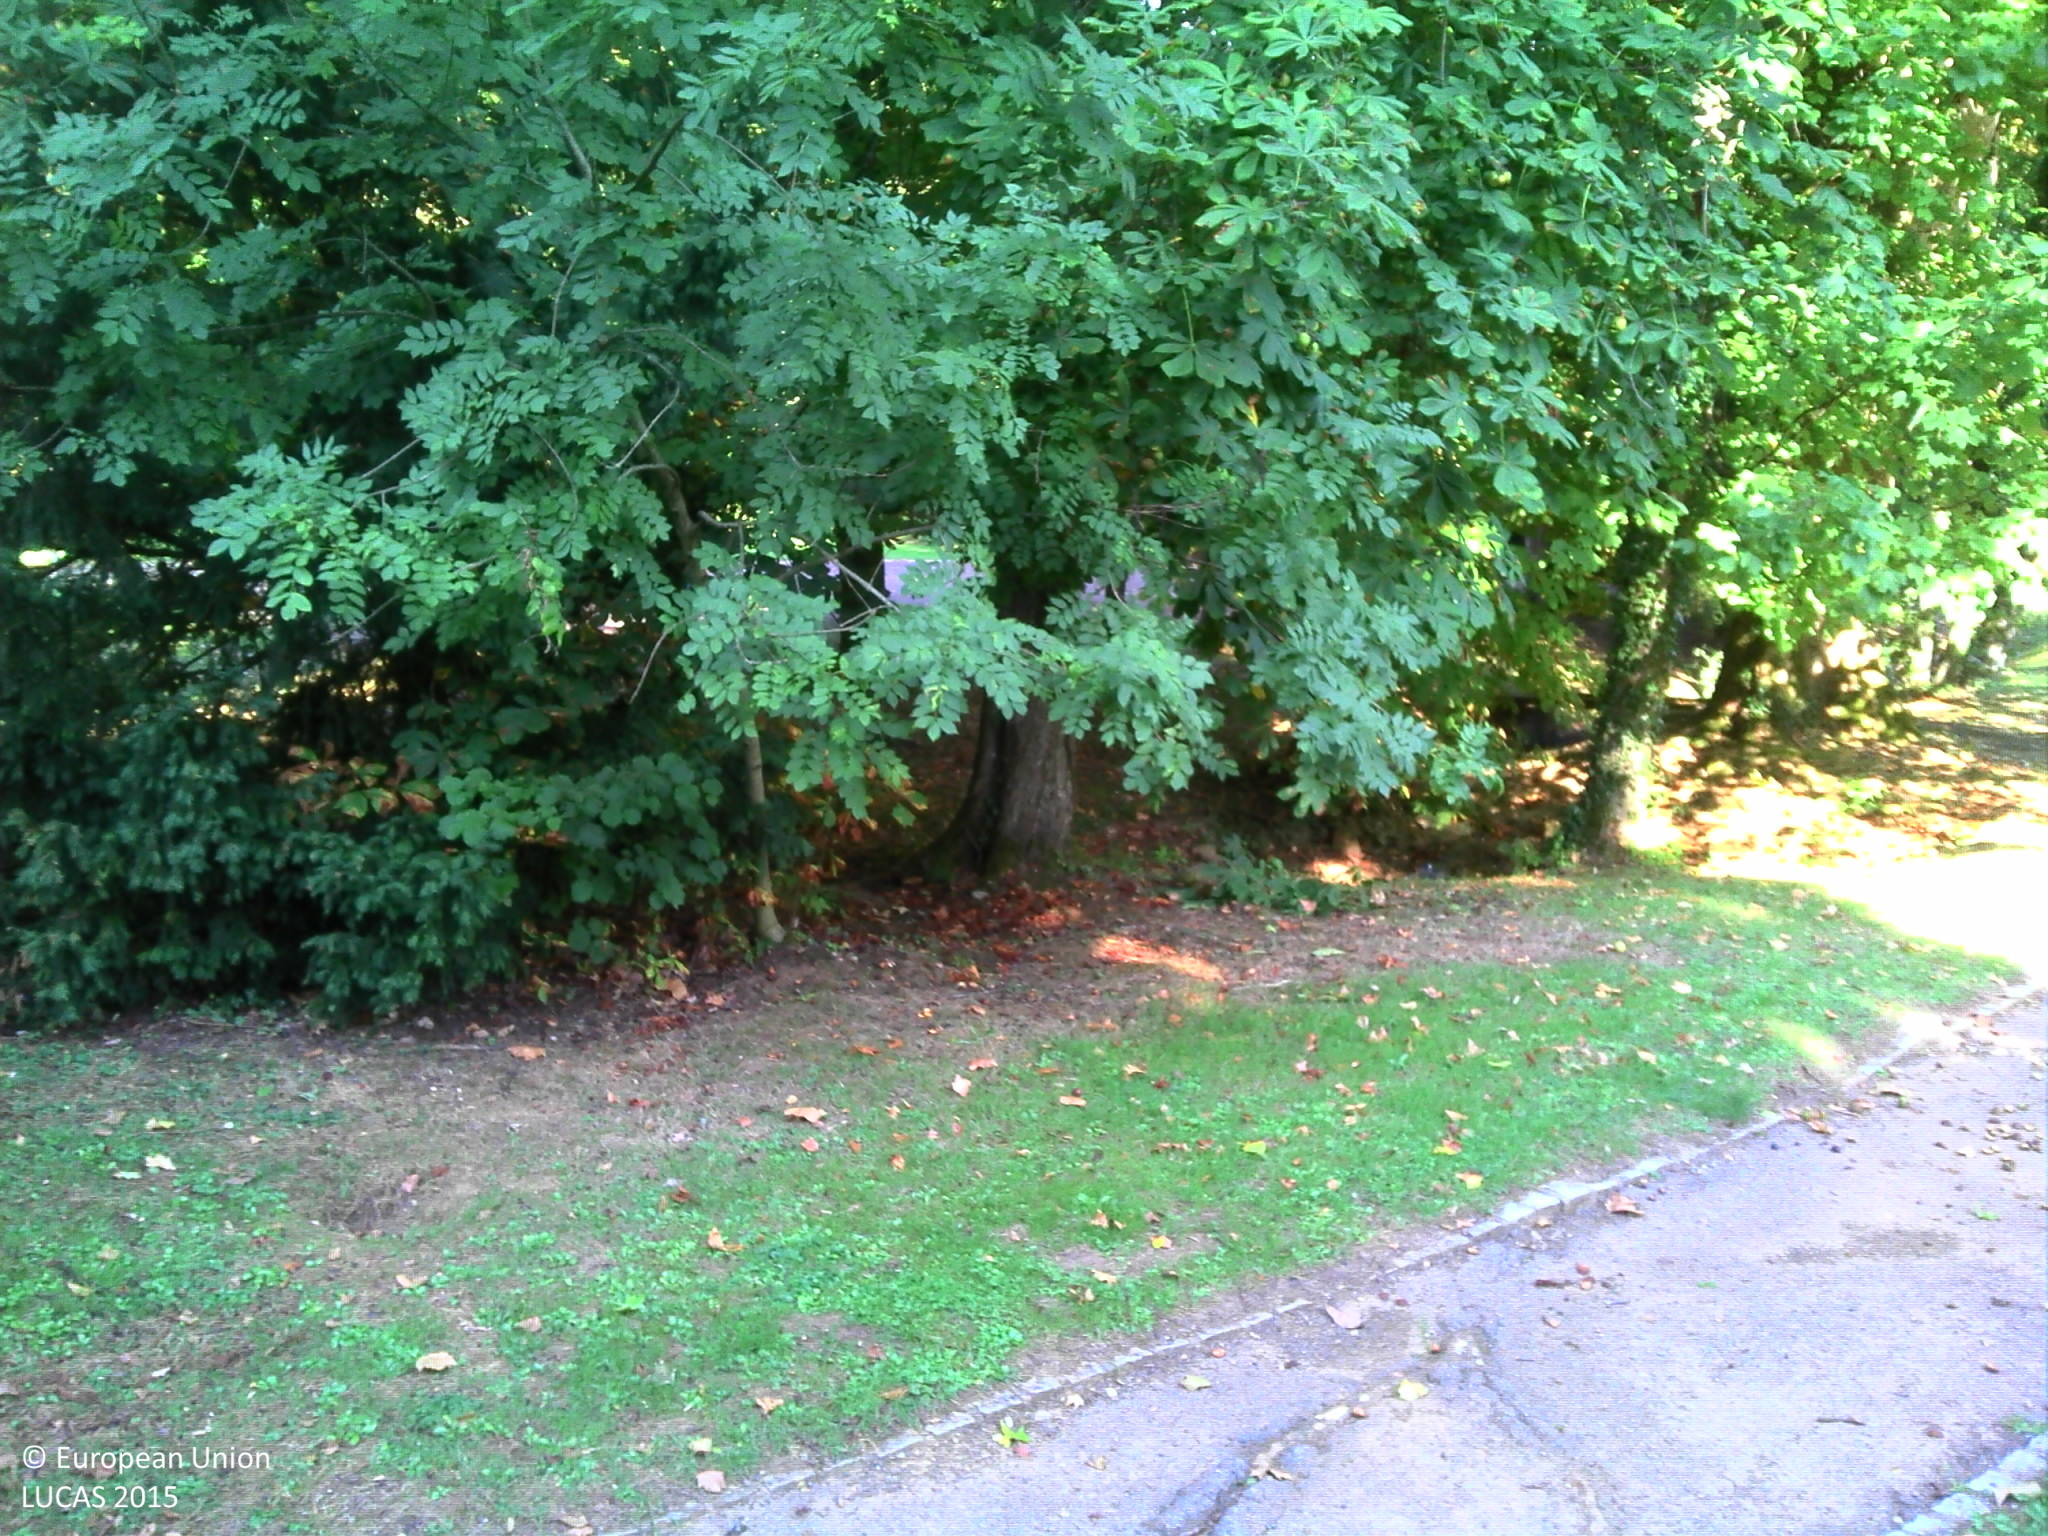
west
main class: Grassland
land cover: Grassland without tree/shrub cover
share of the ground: > 75 %
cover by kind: herbaceous plants 70 %, consolidated bare surface 10 %
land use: Amenities, museums, leisure
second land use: Sport
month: September
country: FR
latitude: 47.3228
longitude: 6.0191
